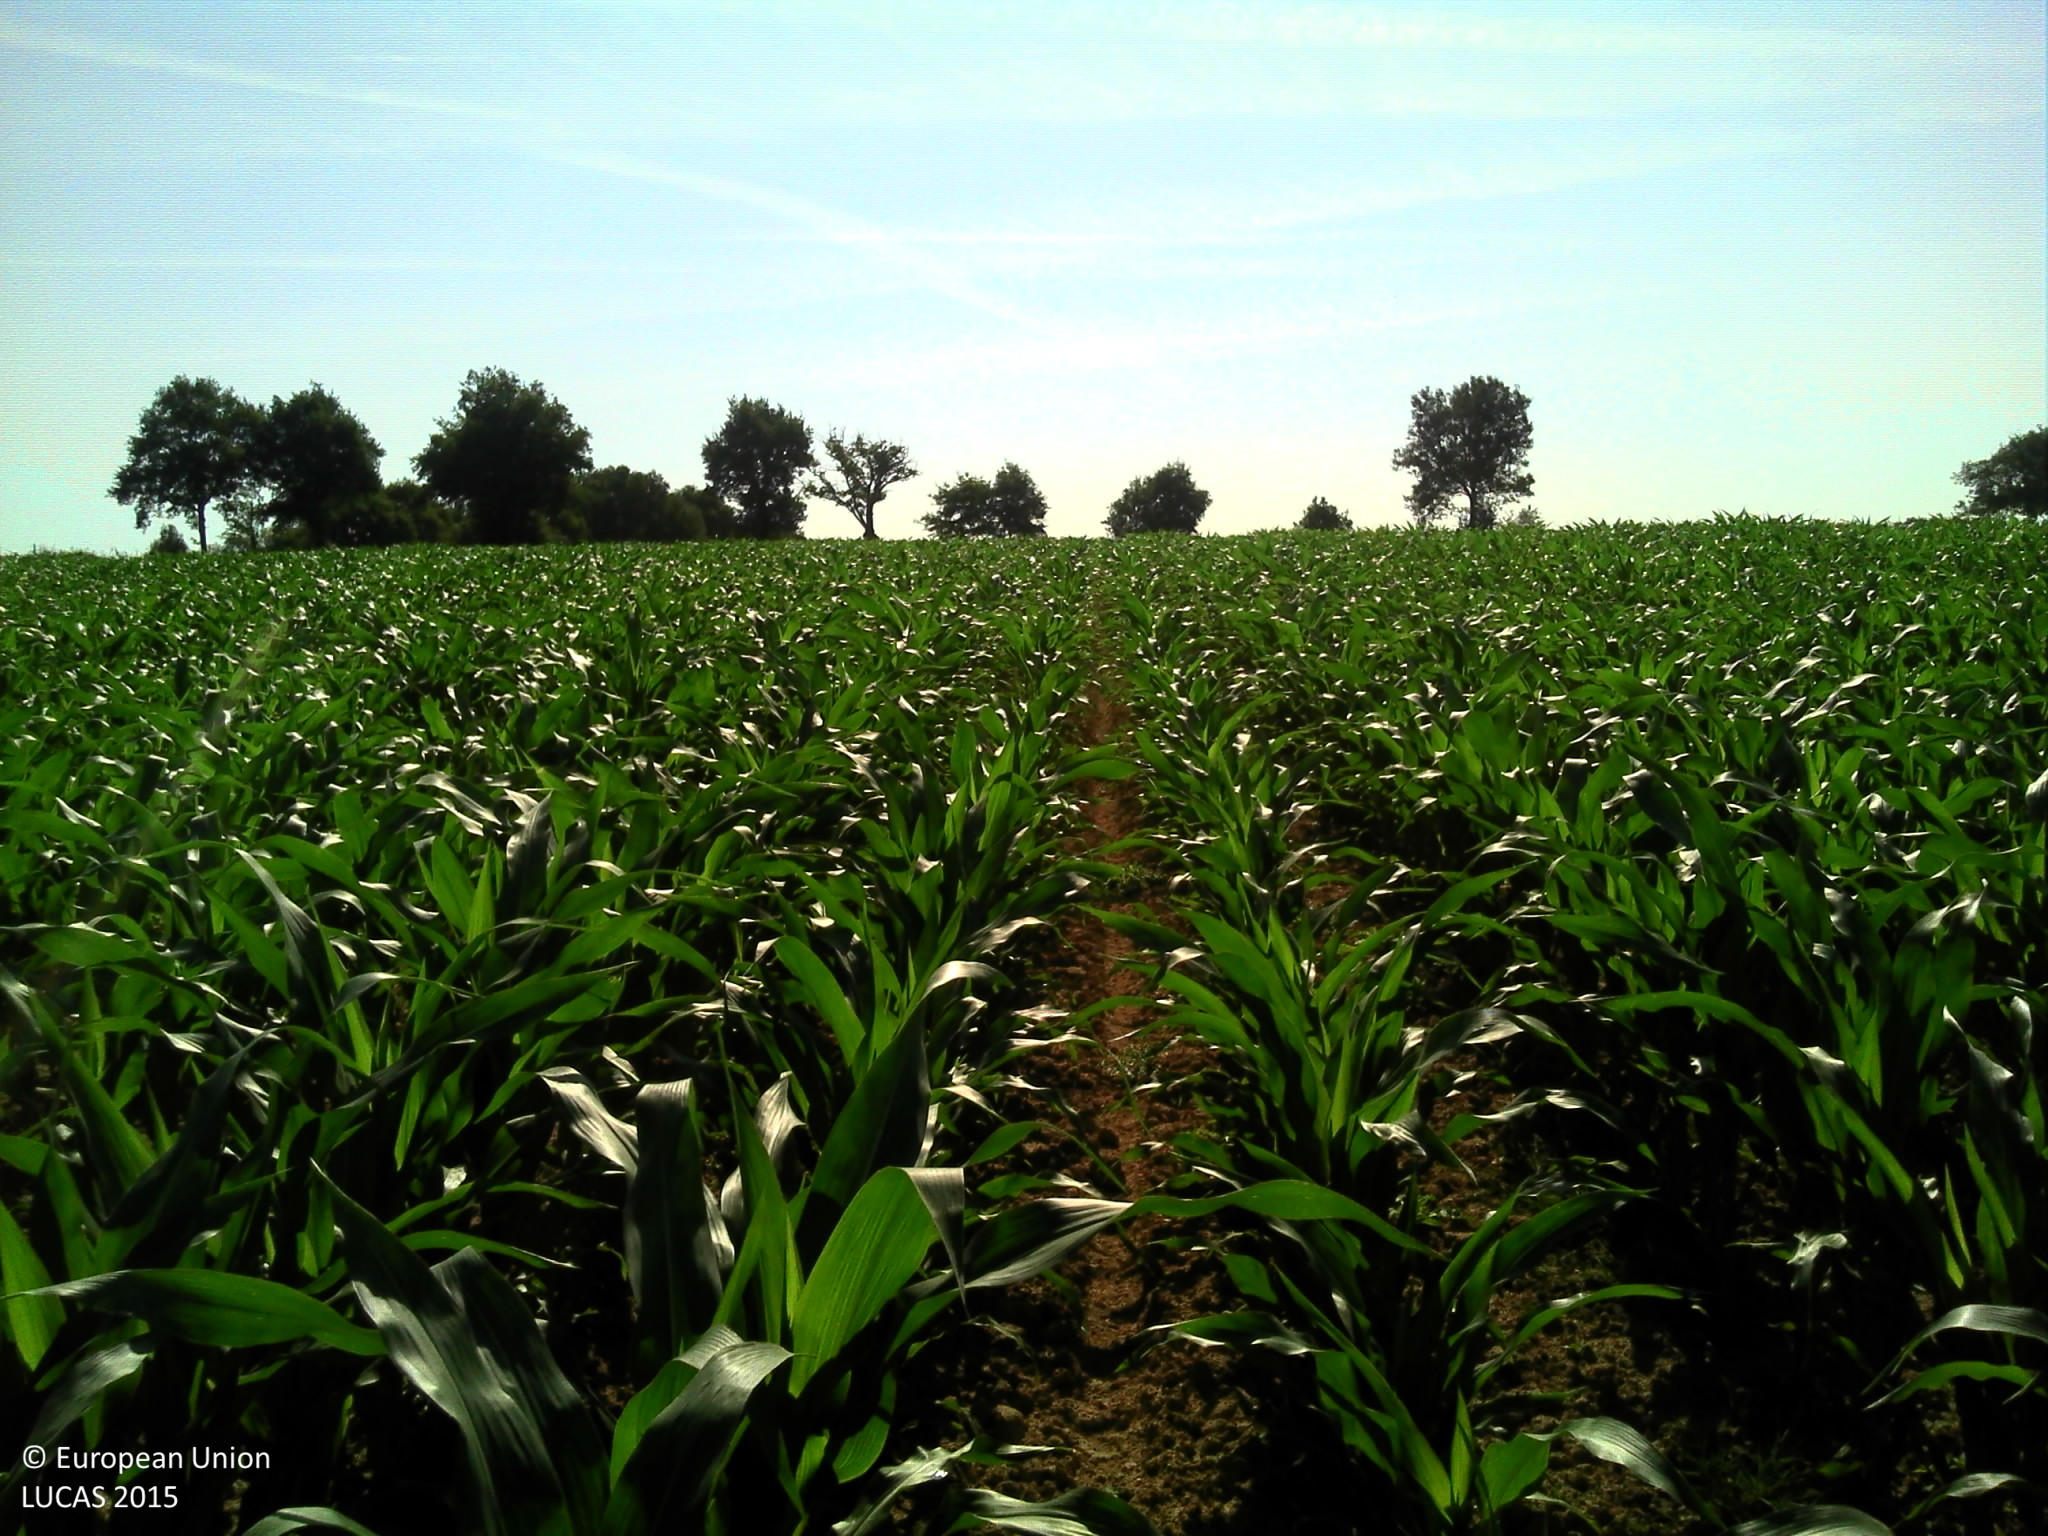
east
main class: Cropland
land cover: Maize
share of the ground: > 75 %
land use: Agriculture (excluding fallow land and kitchen gardens)
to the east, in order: Maize; Grass margins; Lines of trees; Ditches and canals; Lines of trees; Grass margins; Maize
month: July
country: FR
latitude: 46.3078
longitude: 0.9103
